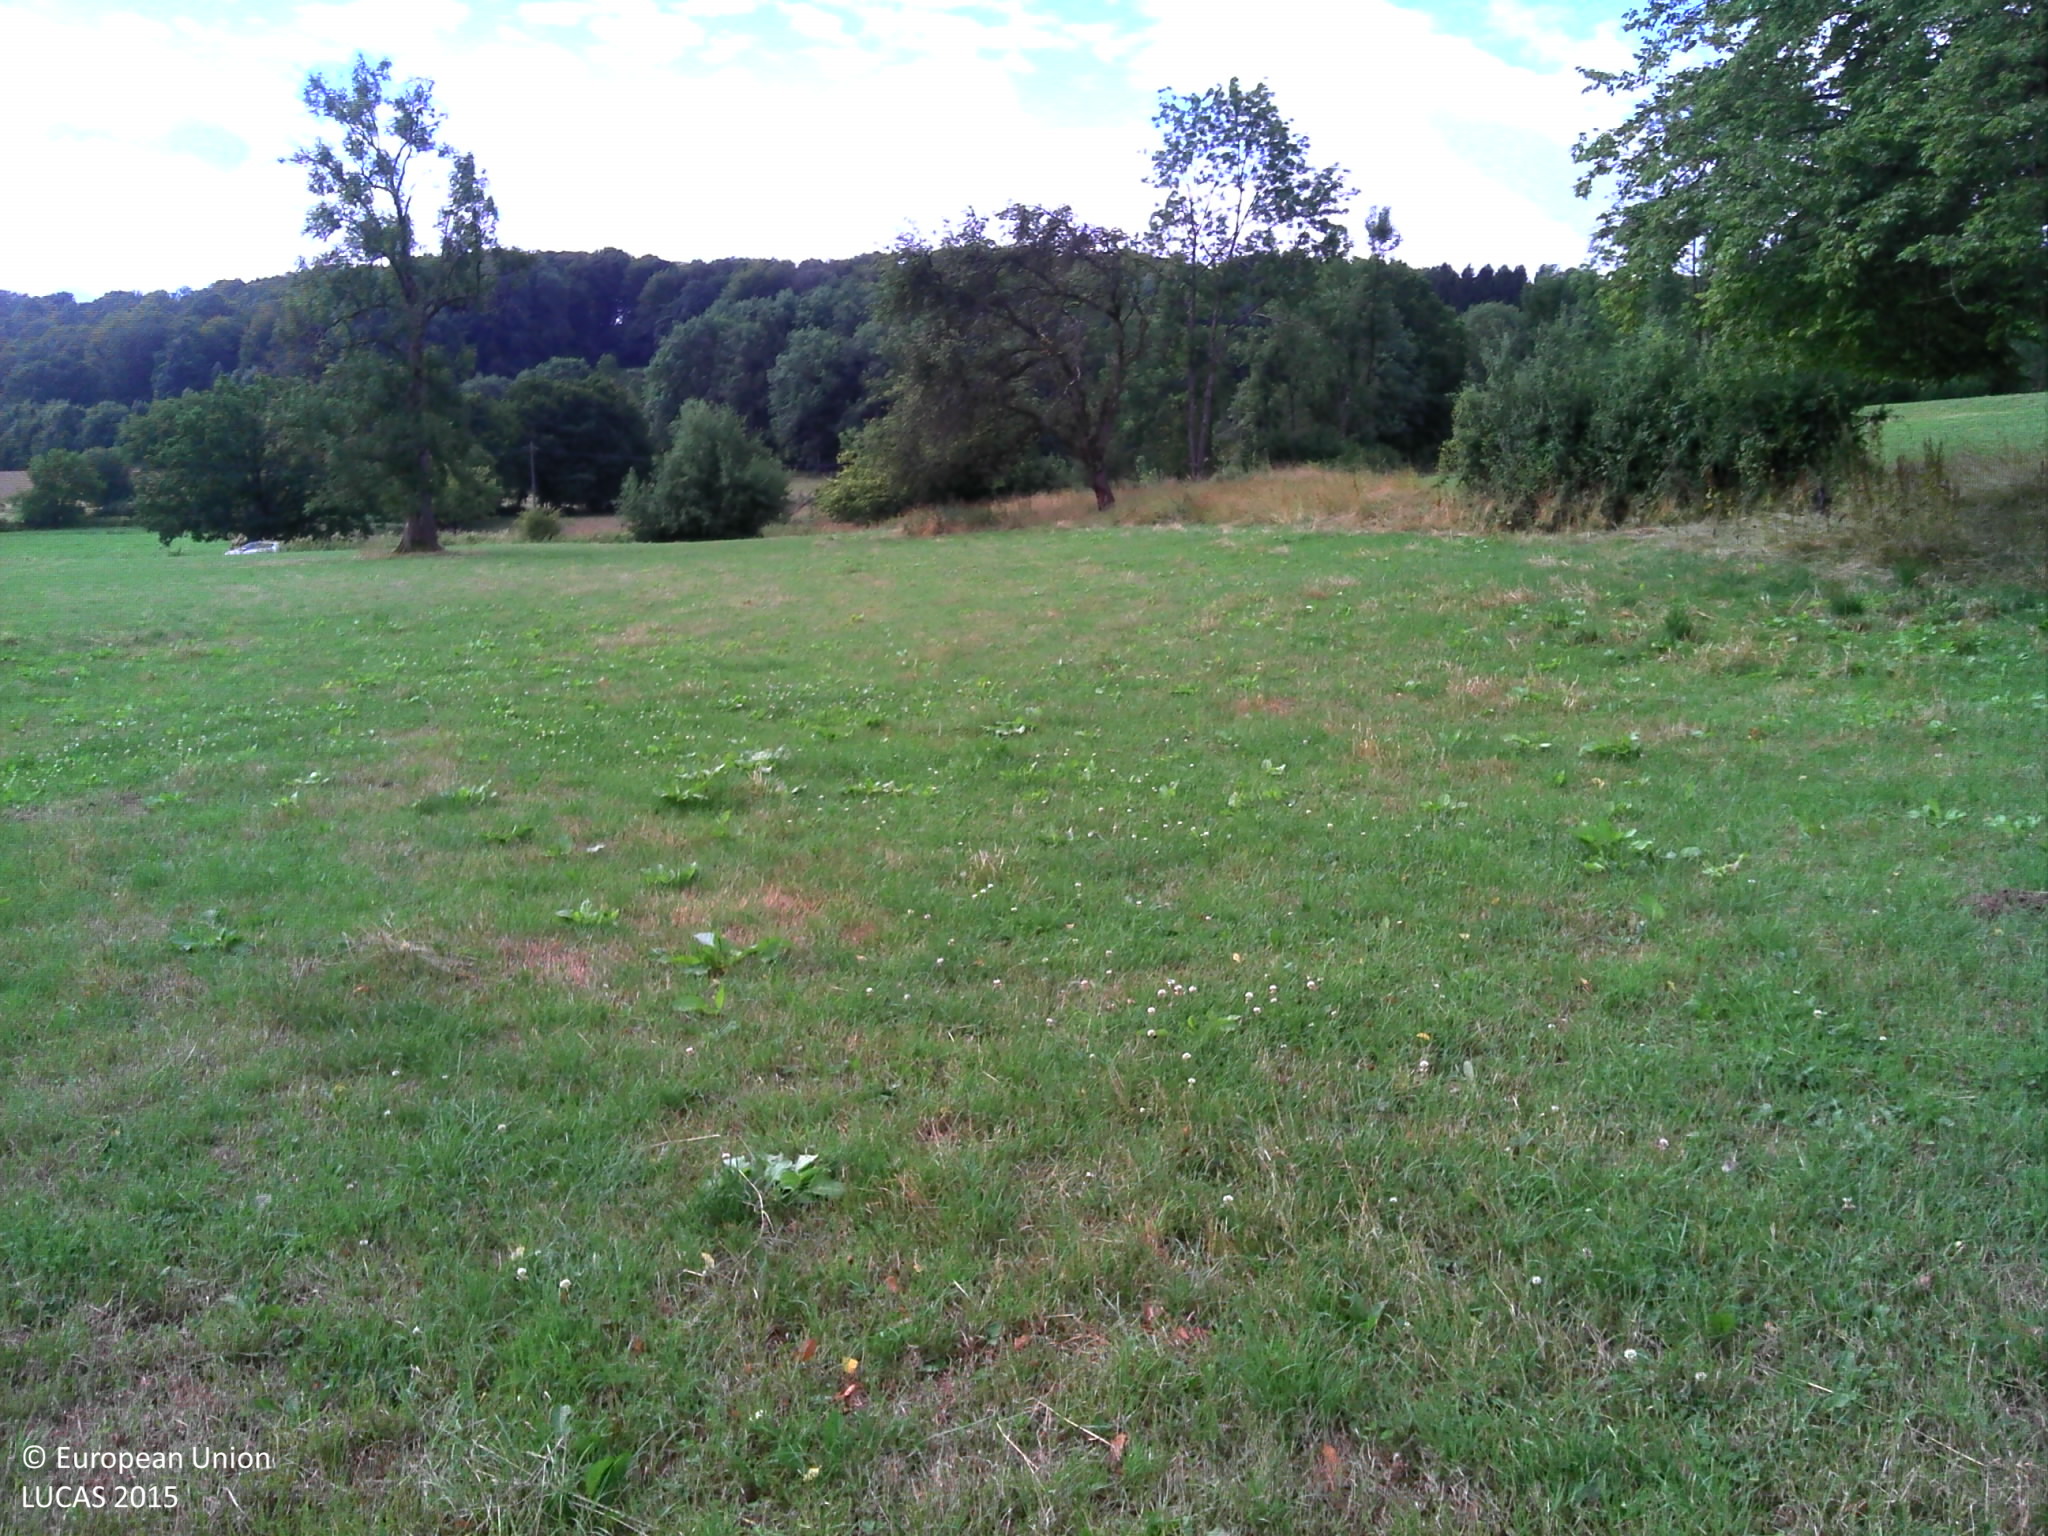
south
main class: Grassland
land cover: Grassland without tree/shrub cover
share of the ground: > 75 %
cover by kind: herbaceous plants 100 %
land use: Agriculture (excluding fallow land and kitchen gardens)
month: July
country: BE
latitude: 49.7090
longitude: 5.2970
